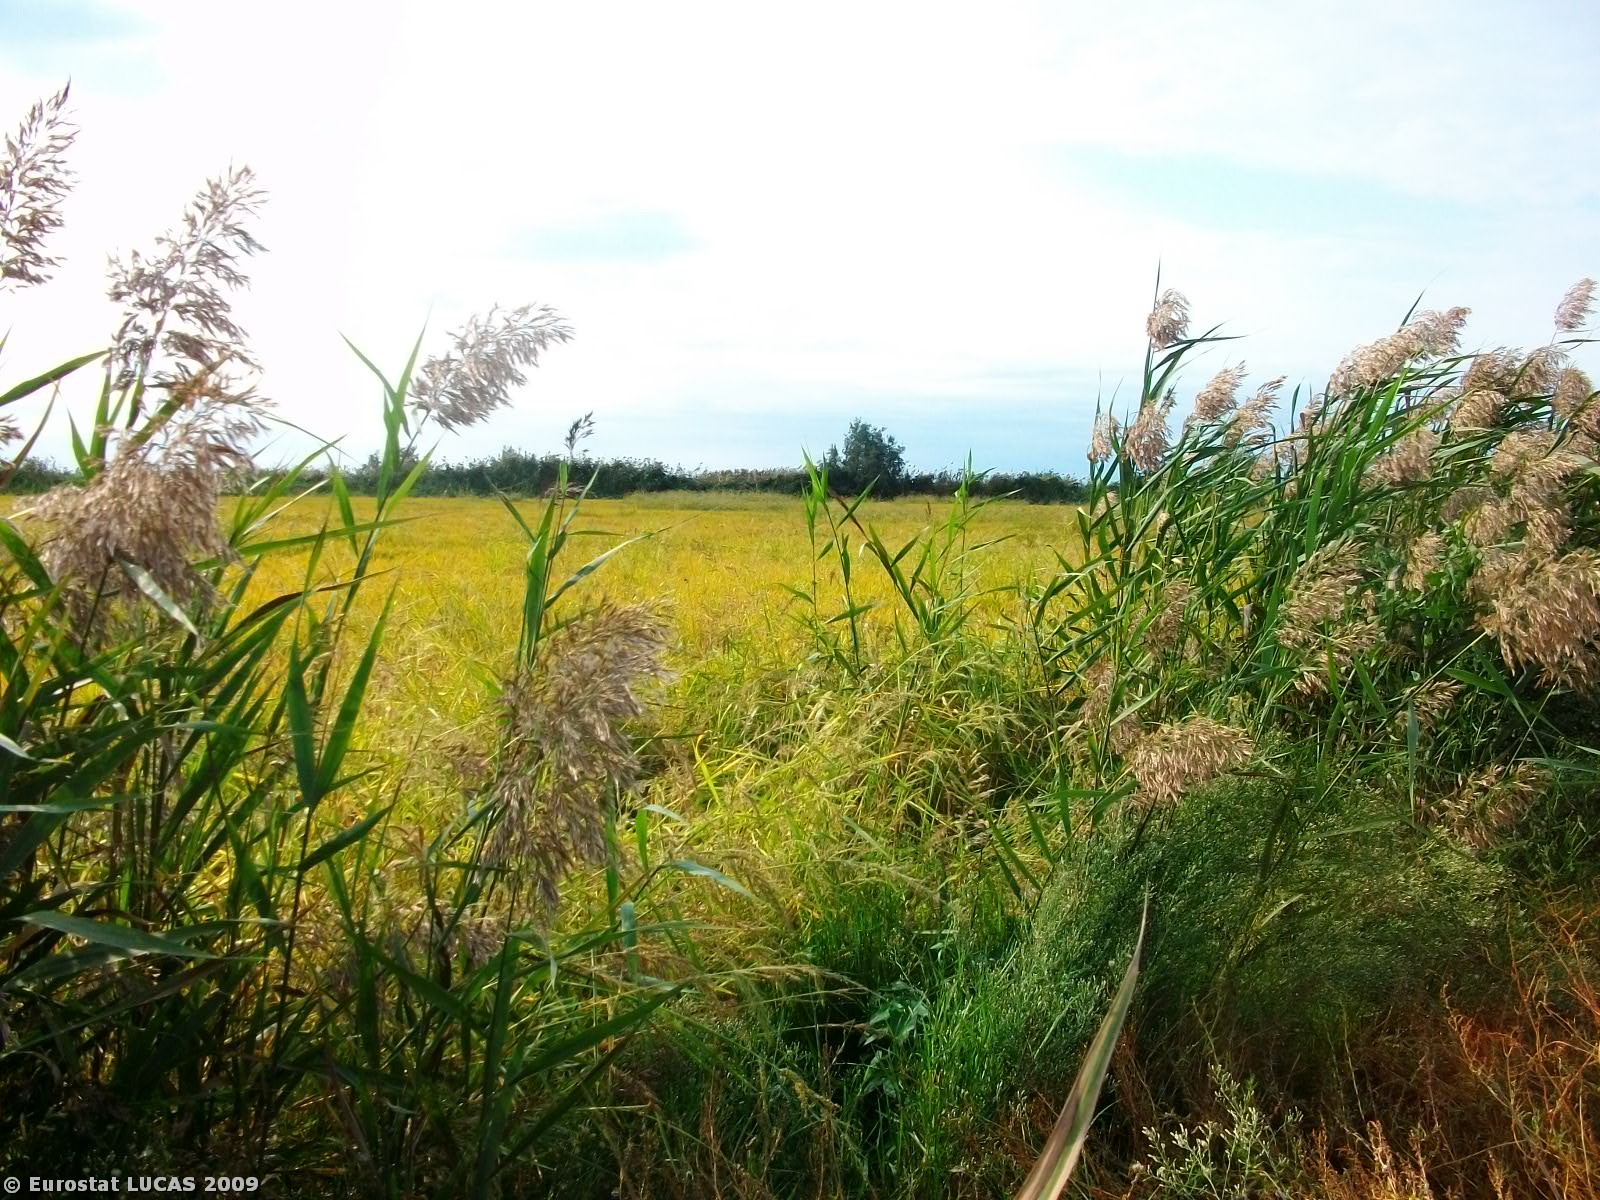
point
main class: Cropland
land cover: Rice
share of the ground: > 75 %
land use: Agriculture (excluding fallow land and kitchen gardens)
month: June
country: GR
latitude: 40.5275
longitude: 22.6214
